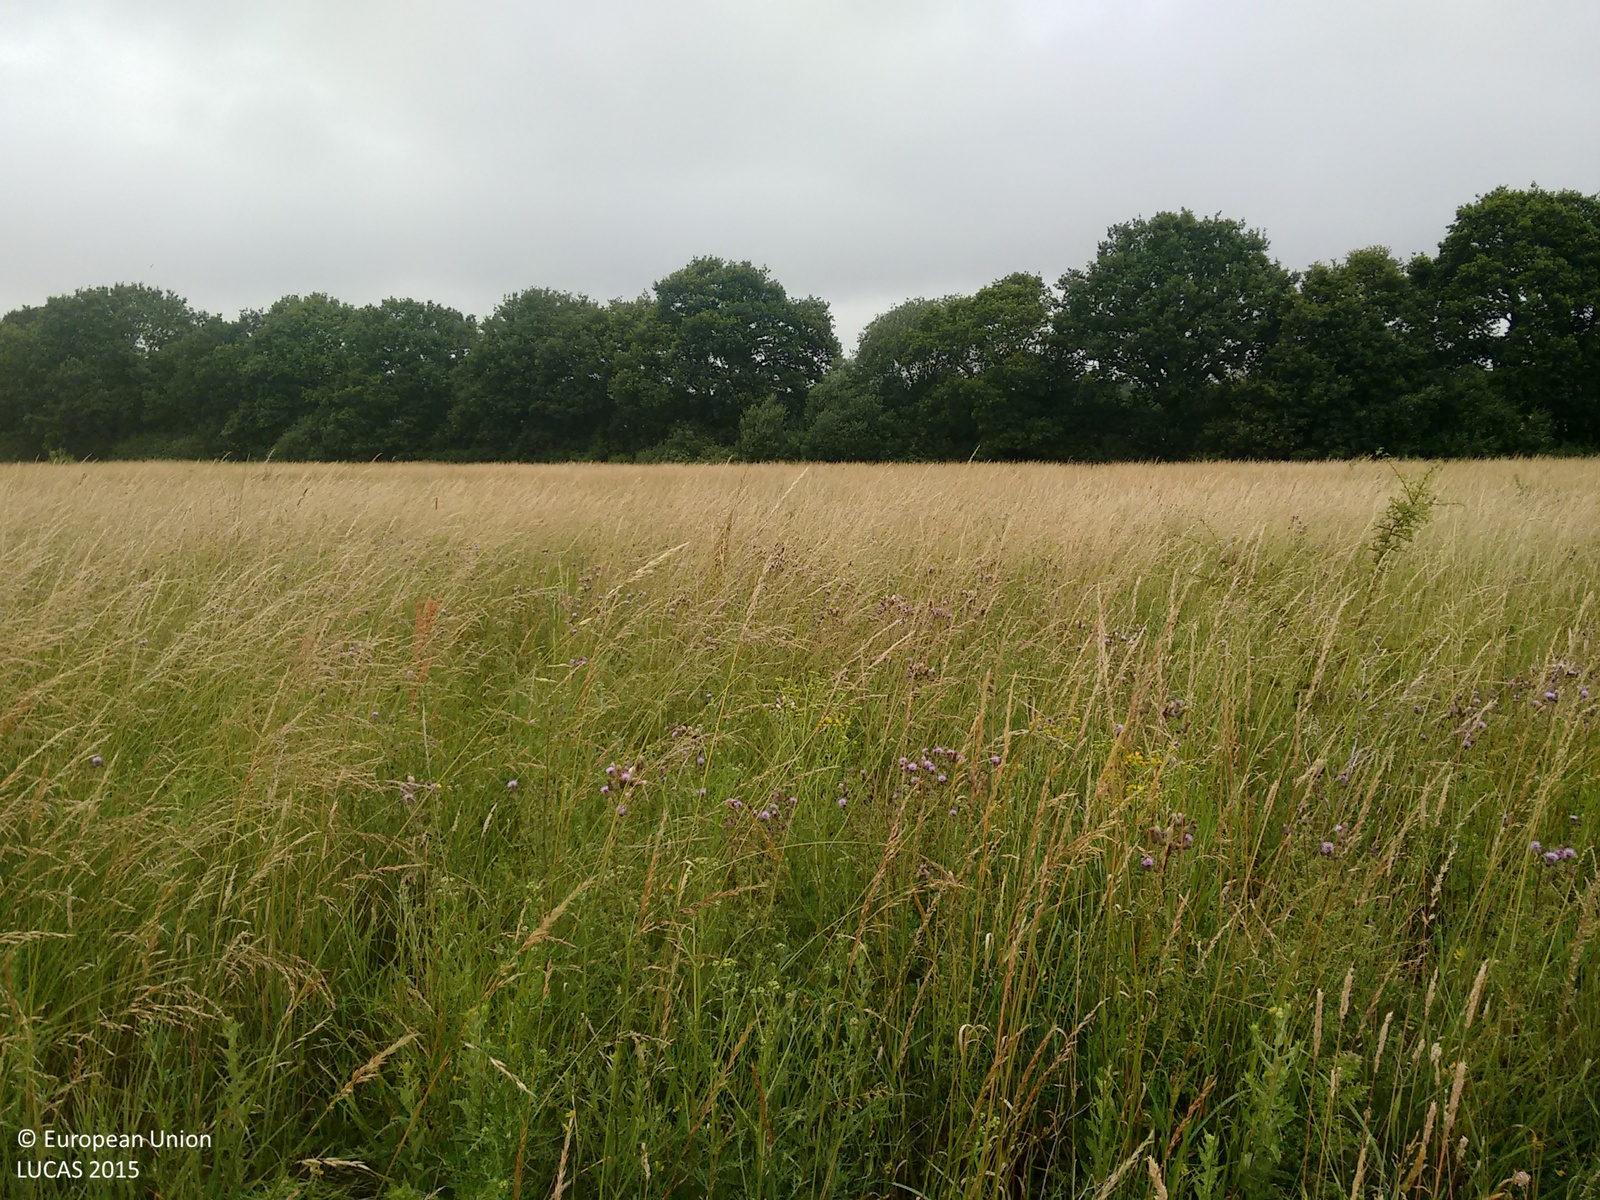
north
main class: Grassland
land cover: Grassland without tree/shrub cover
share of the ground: > 75 %
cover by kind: herbaceous plants 100 %
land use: Agriculture (excluding fallow land and kitchen gardens)
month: July
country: GB
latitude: 51.6474
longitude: 0.4476
